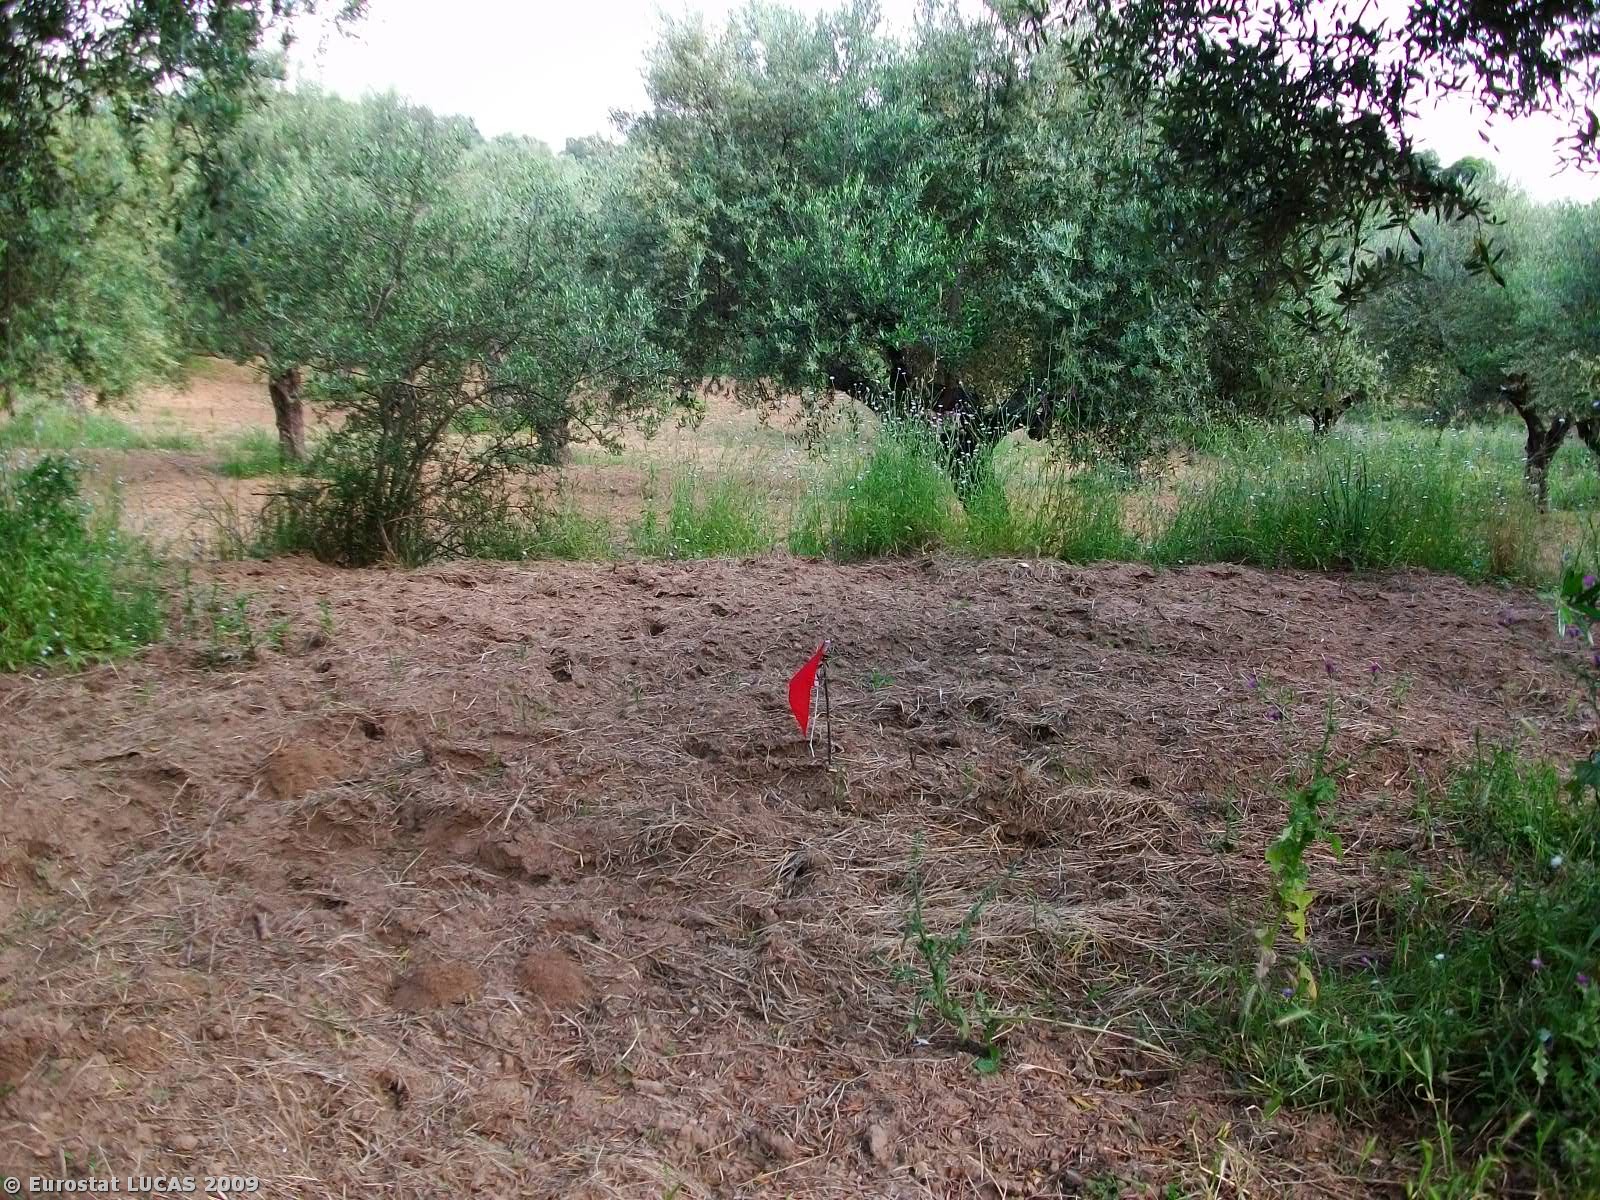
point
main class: Cropland
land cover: Olive groves
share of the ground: > 75 %
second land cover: Bare land
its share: 50 - 75 %
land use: Agriculture (excluding fallow land and kitchen gardens)
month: May
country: GR
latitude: 37.1121
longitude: 22.0066
